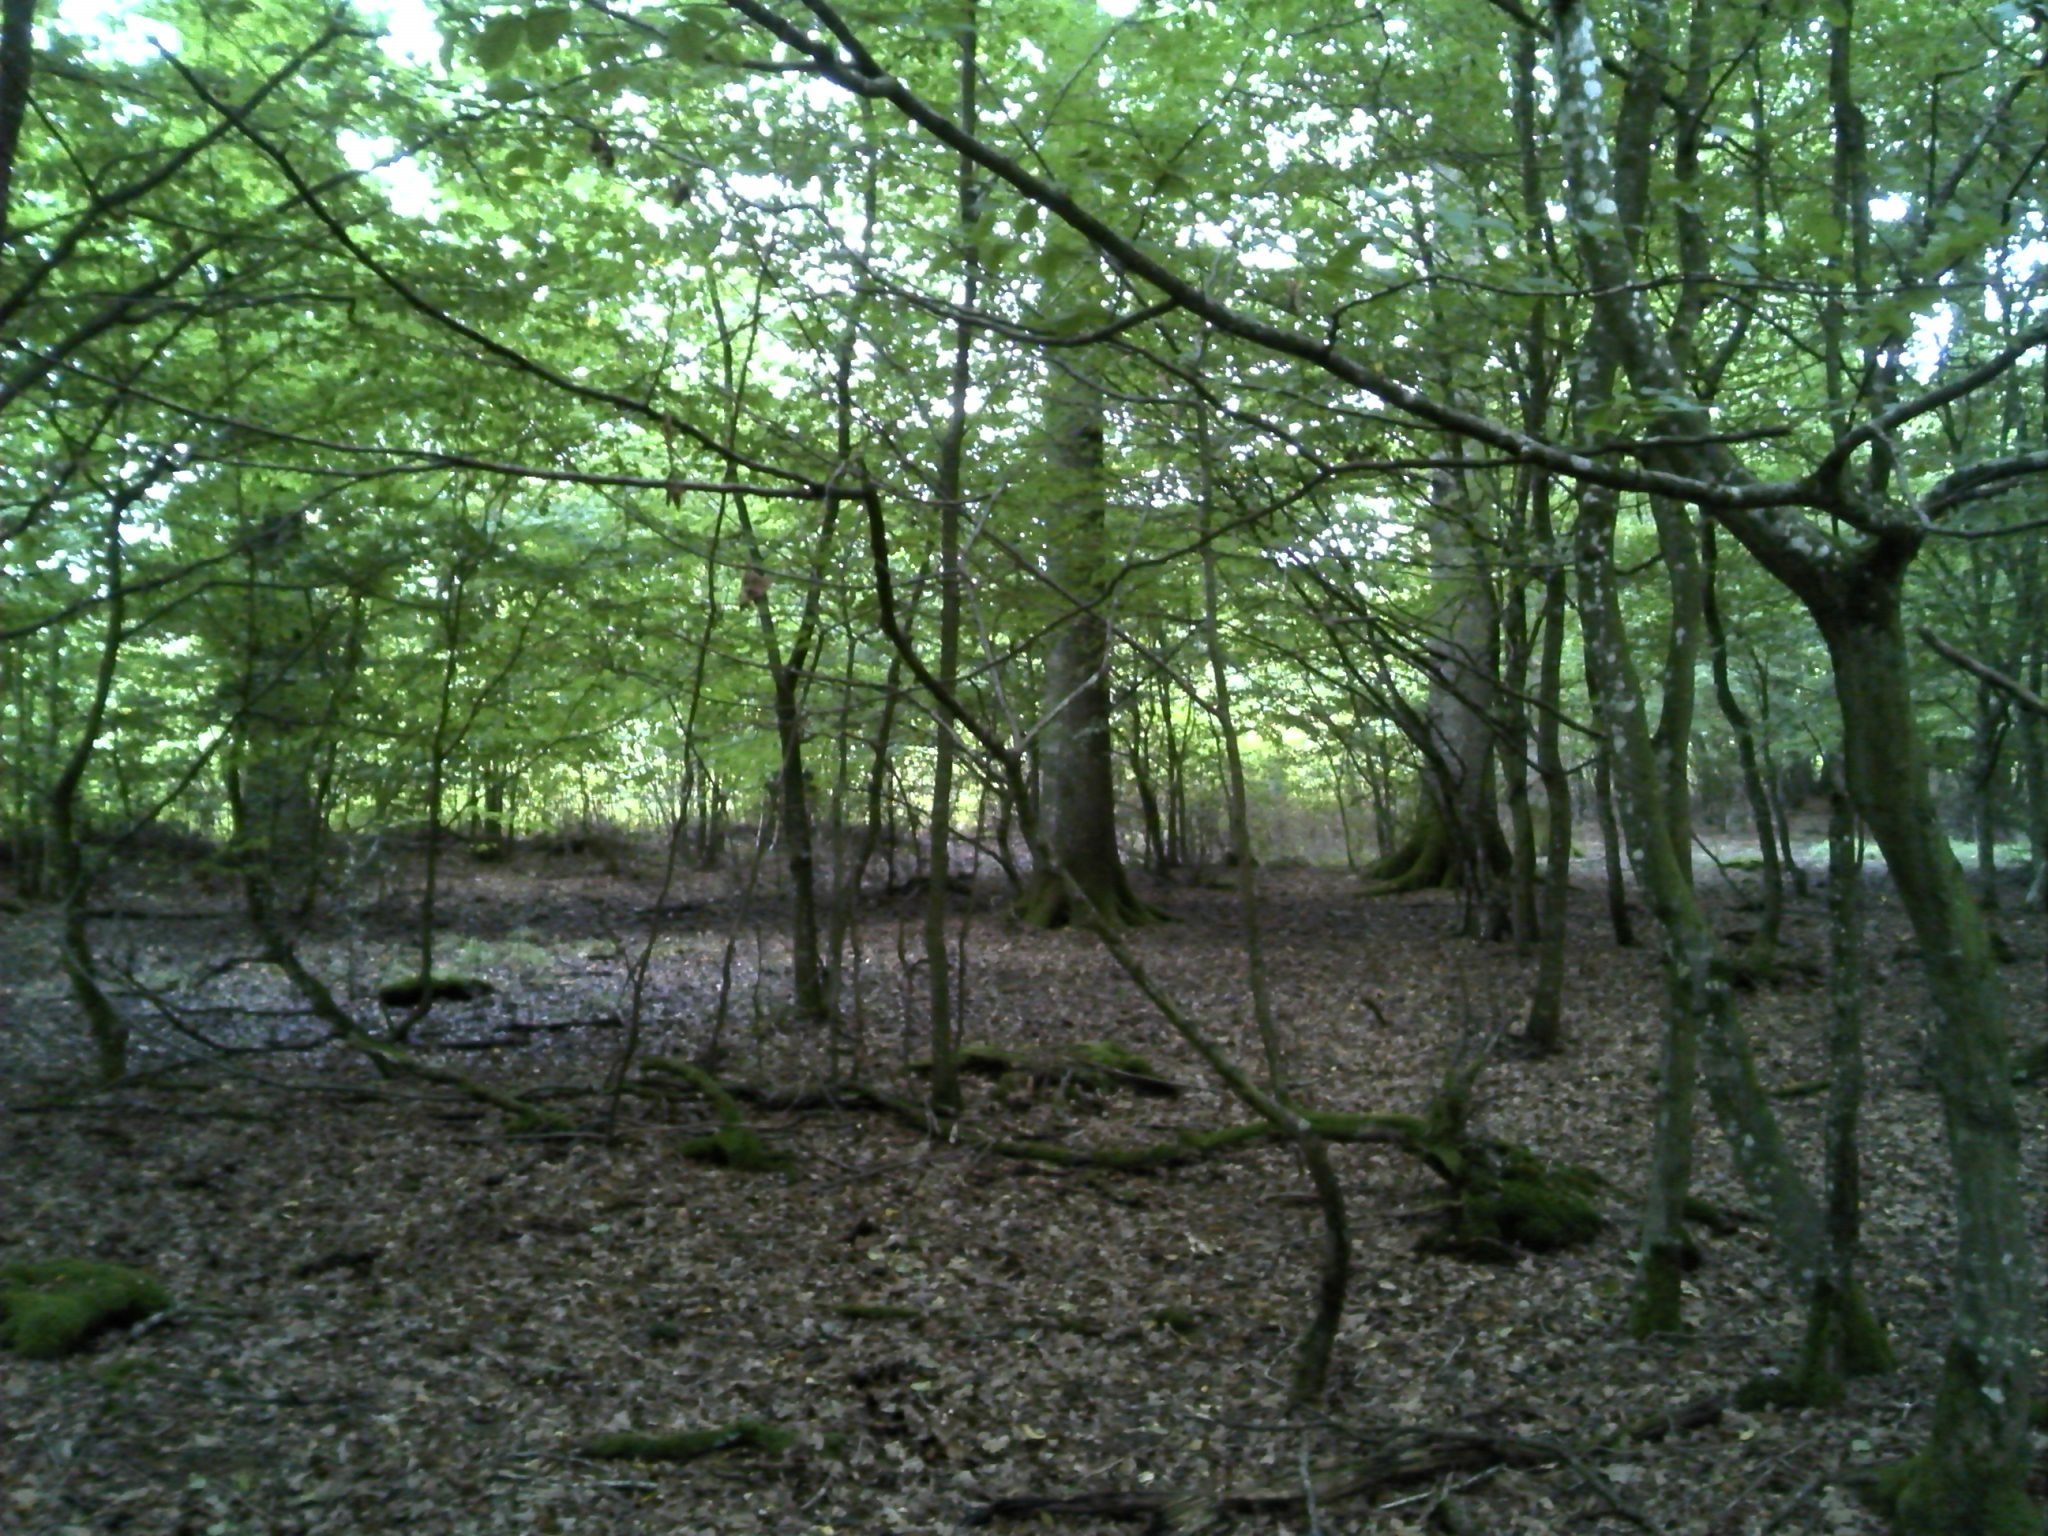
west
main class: Woodland
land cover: Broadleaved woodland
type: mesophytic deciduous forest
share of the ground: > 75 %
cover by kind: broadleaved forest trees 90 %, herbaceous plants 5 %, lichens and mosses 5 %
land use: Forestry
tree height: > 5 m
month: September
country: FR
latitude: 47.9696
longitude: 0.6419
